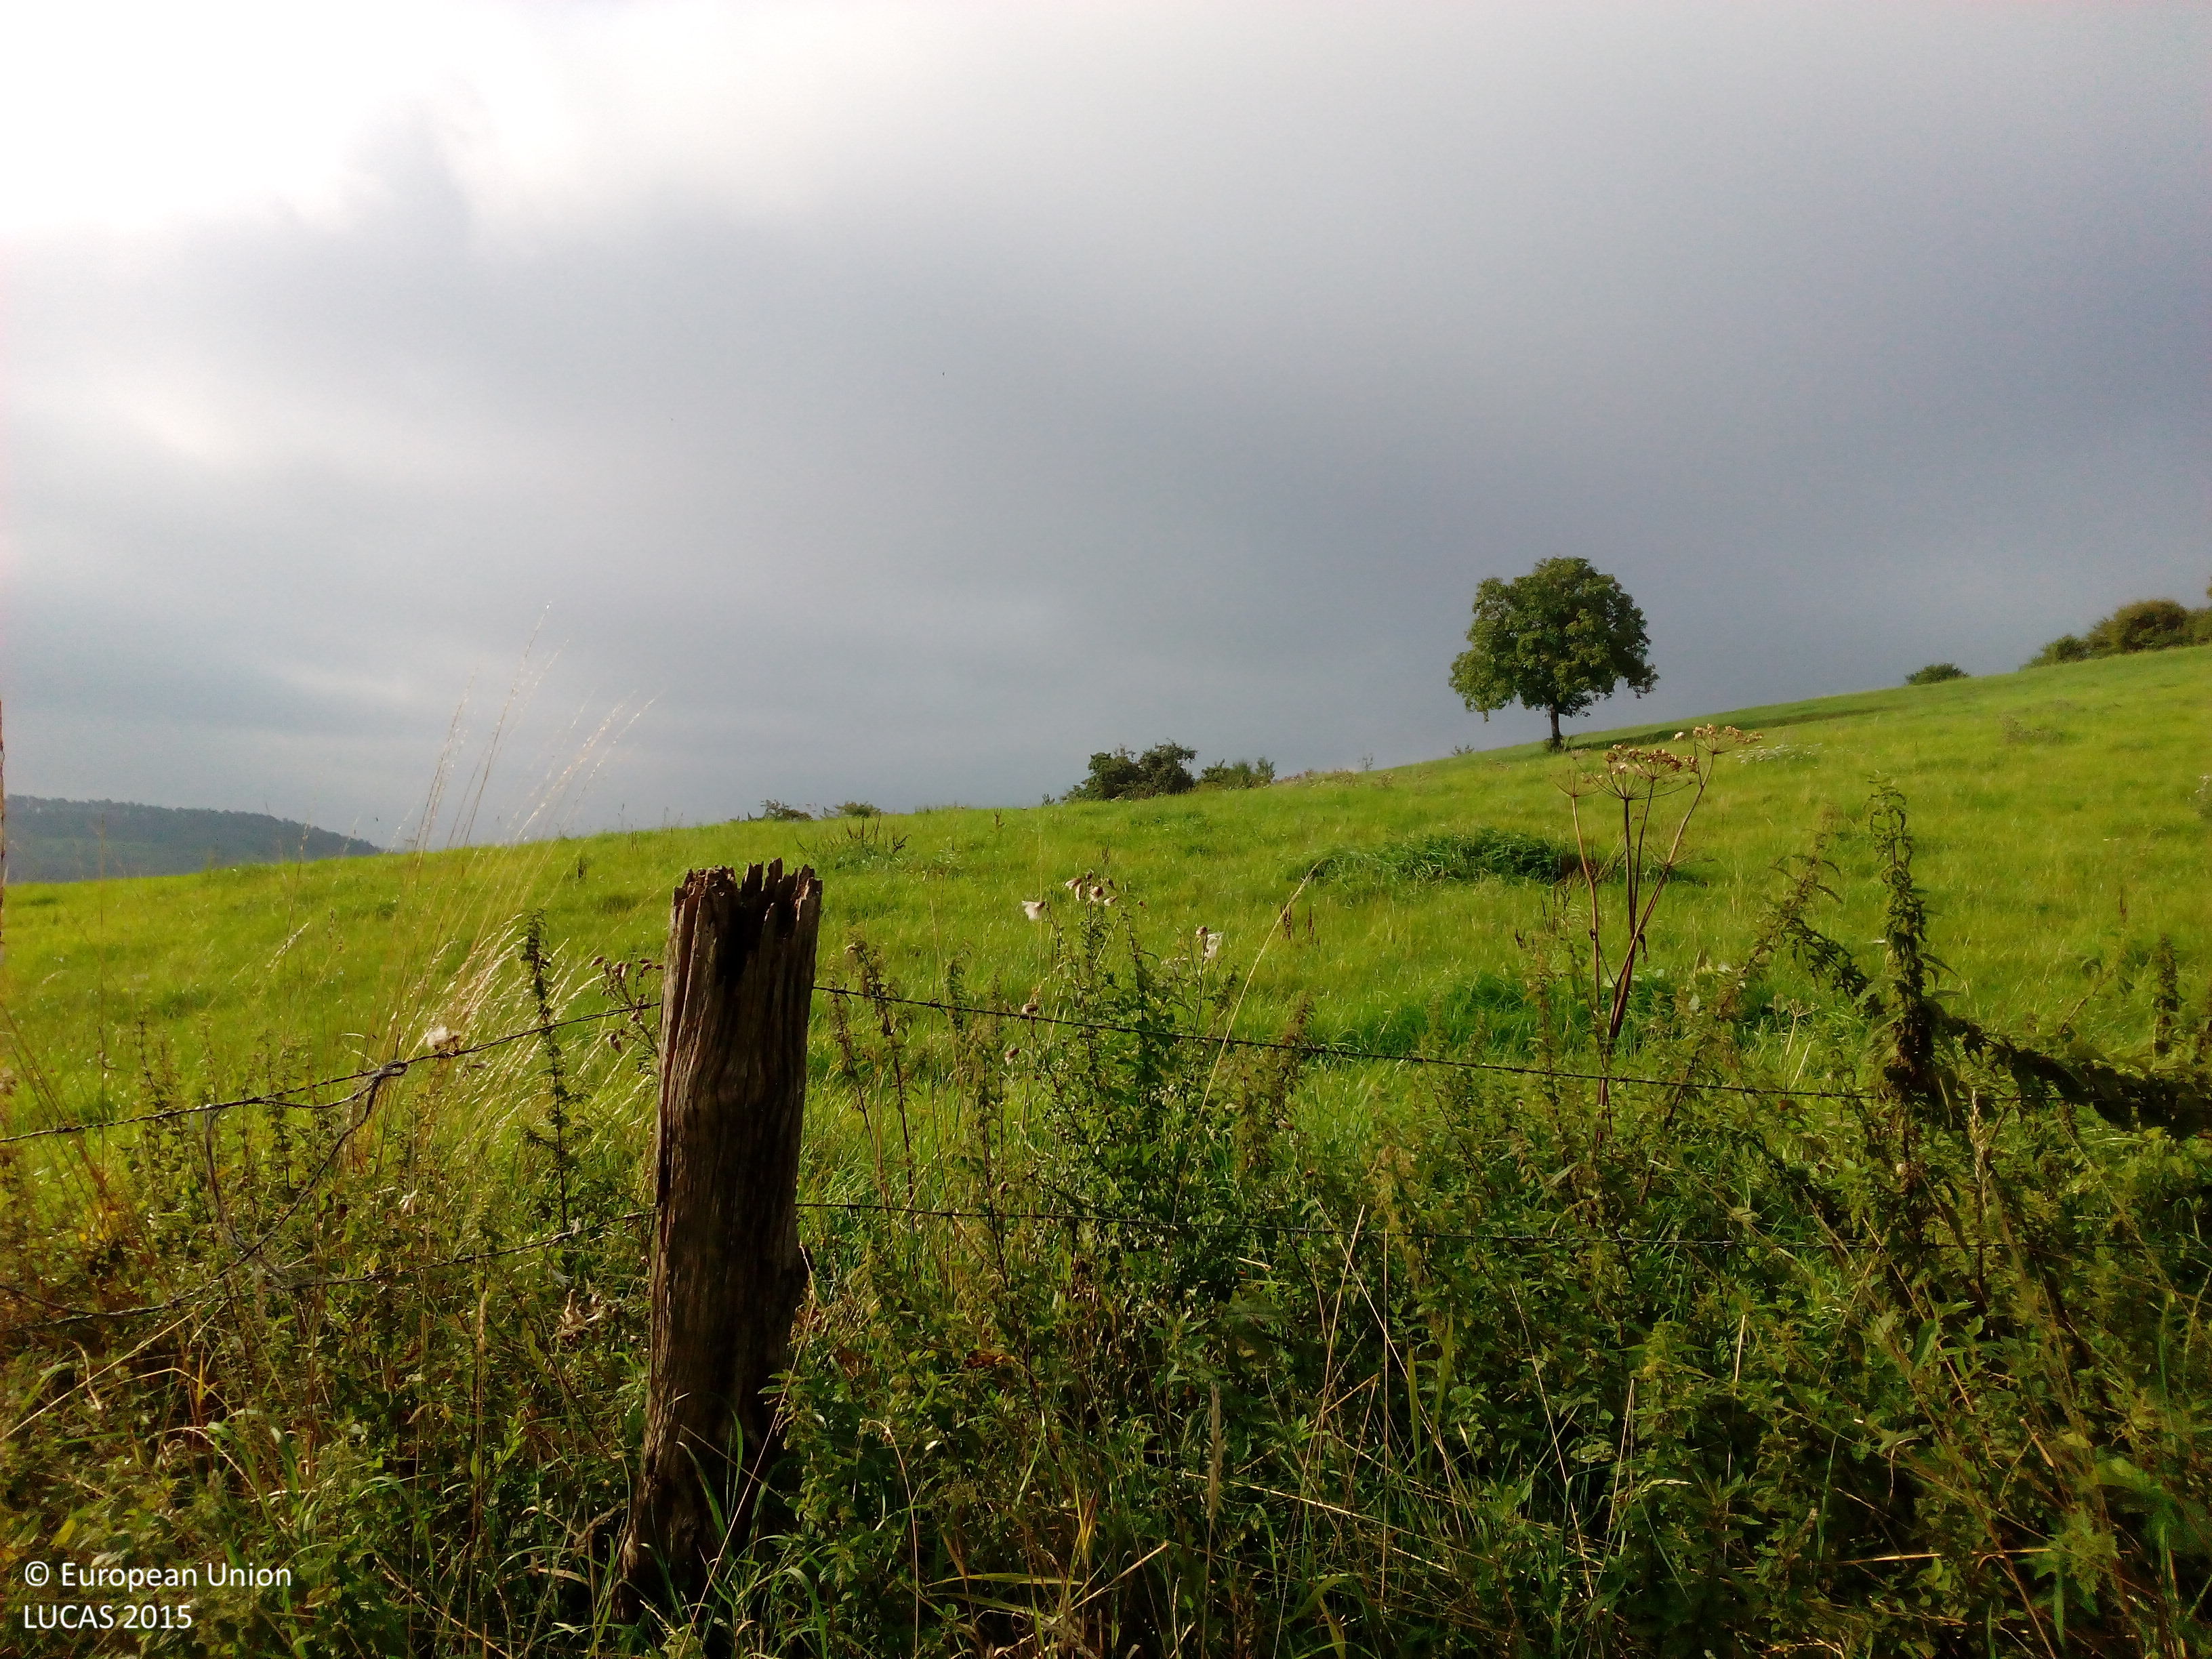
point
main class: Grassland
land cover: Grassland with sparse tree/shrub cover
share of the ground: > 75 %
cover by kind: herbaceous plants 90 %, broadleaved forest trees 5 %, shrubs 5 %
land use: Agriculture (excluding fallow land and kitchen gardens)
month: September
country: DE
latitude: 51.4068
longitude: 9.9569
